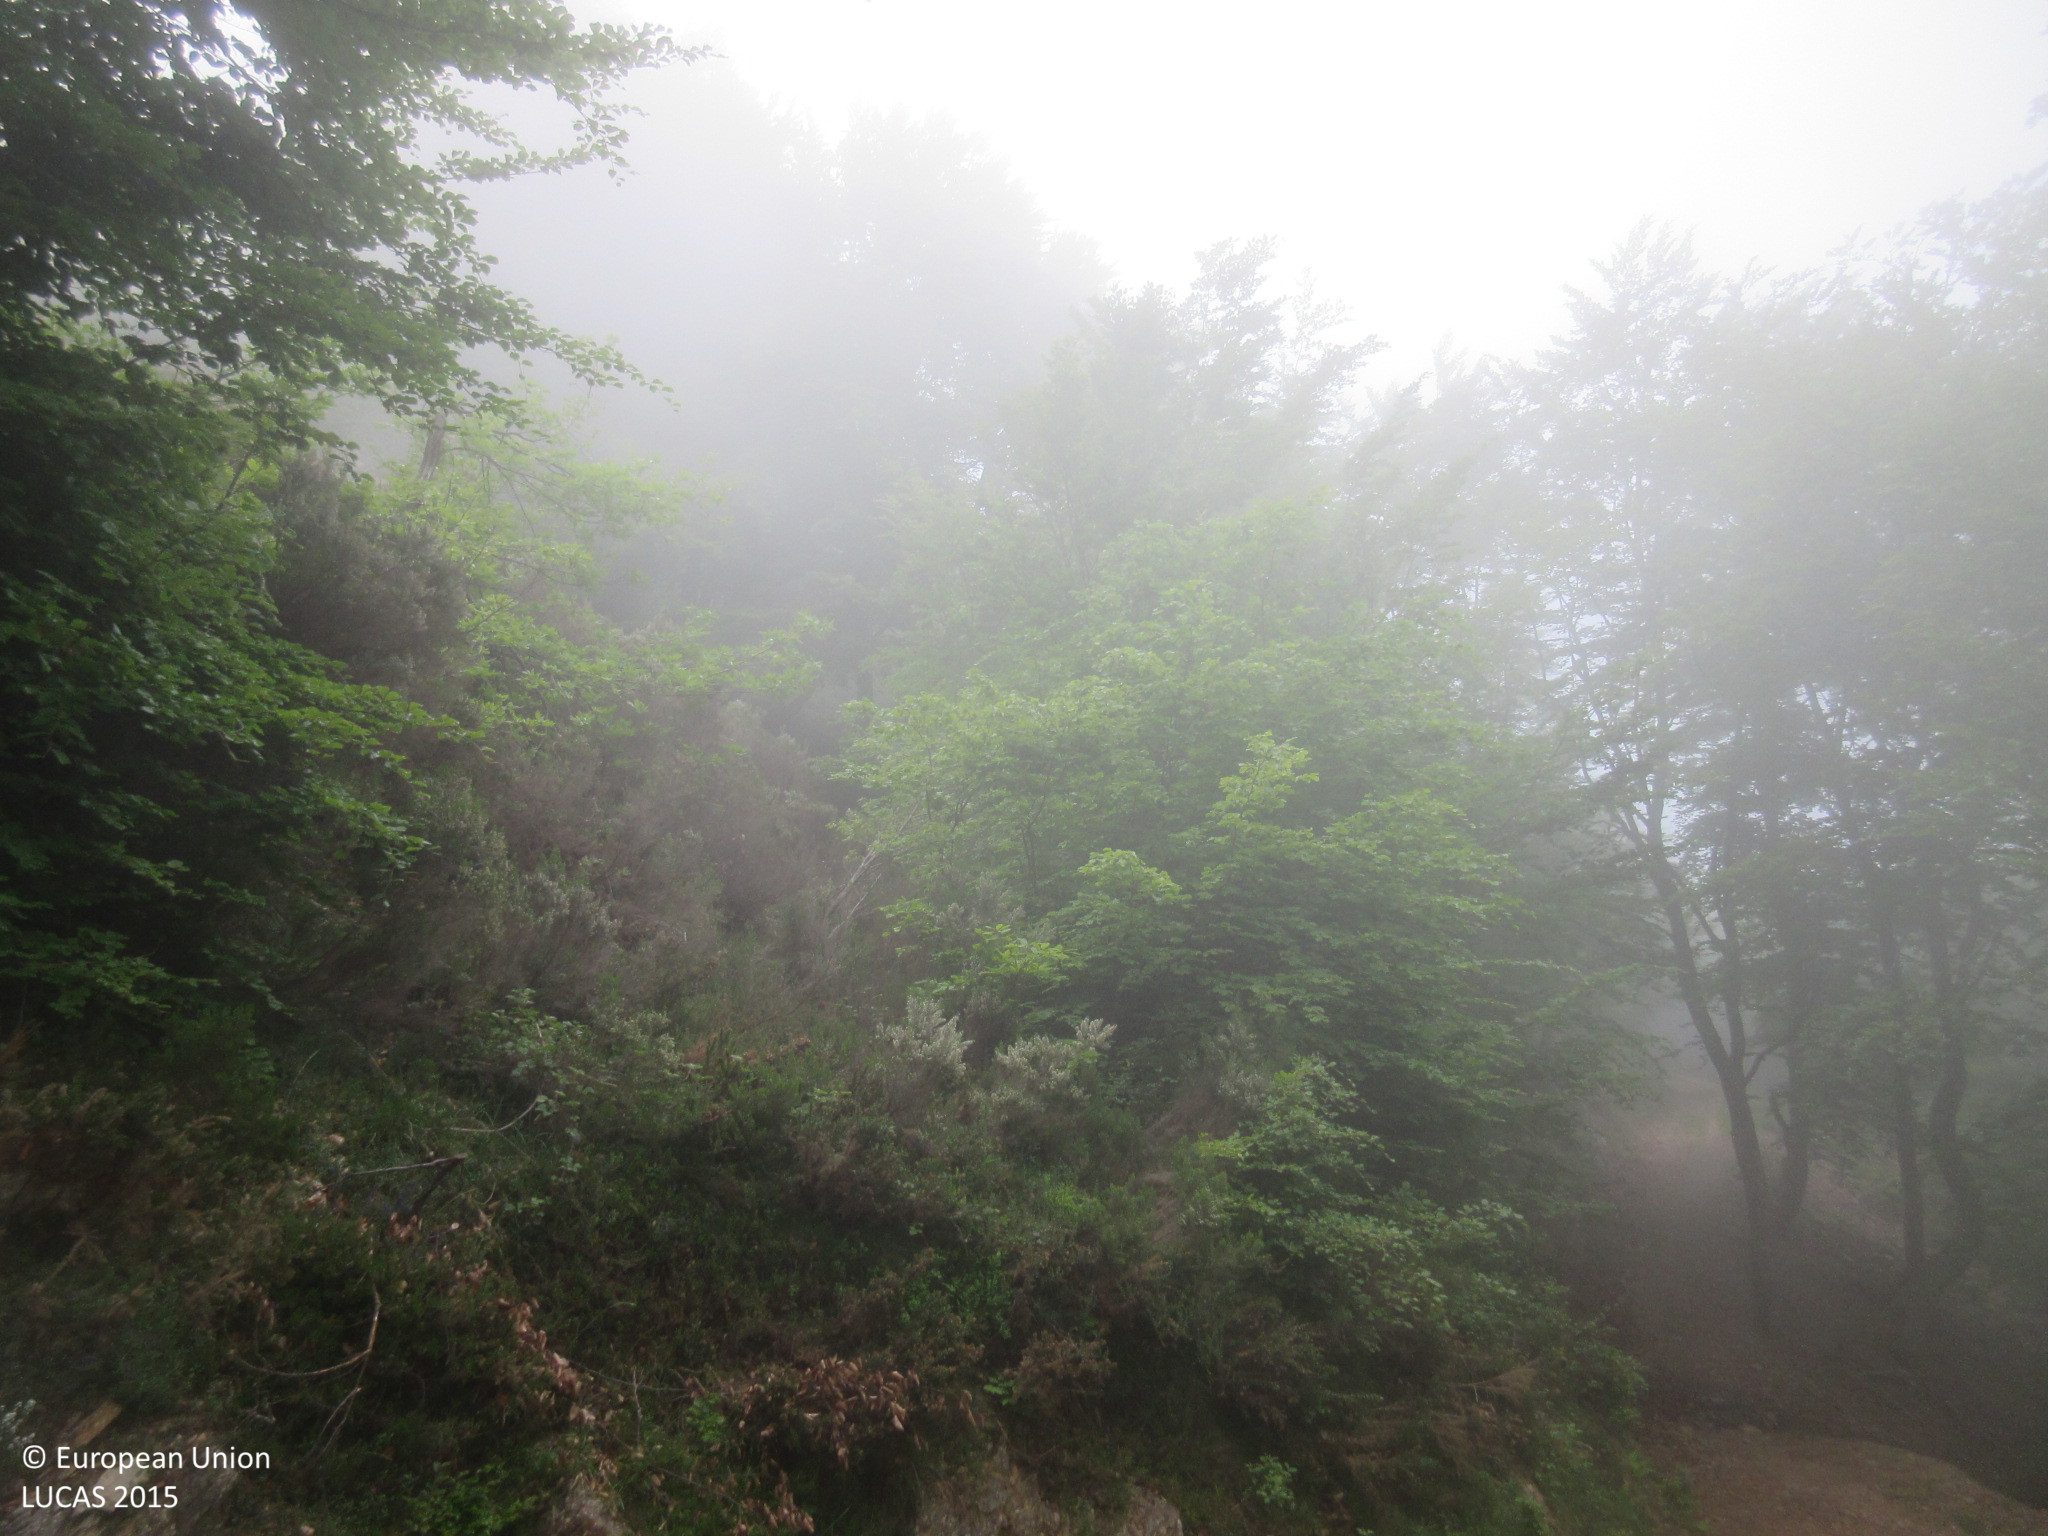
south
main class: Woodland
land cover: Broadleaved woodland
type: beech forest
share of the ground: > 75 %
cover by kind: broadleaved forest trees 95 %, shrubs 5 %
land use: Semi-natural and natural areas not in use
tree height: > 5 m
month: June
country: ES
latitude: 43.1597
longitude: -4.5092
